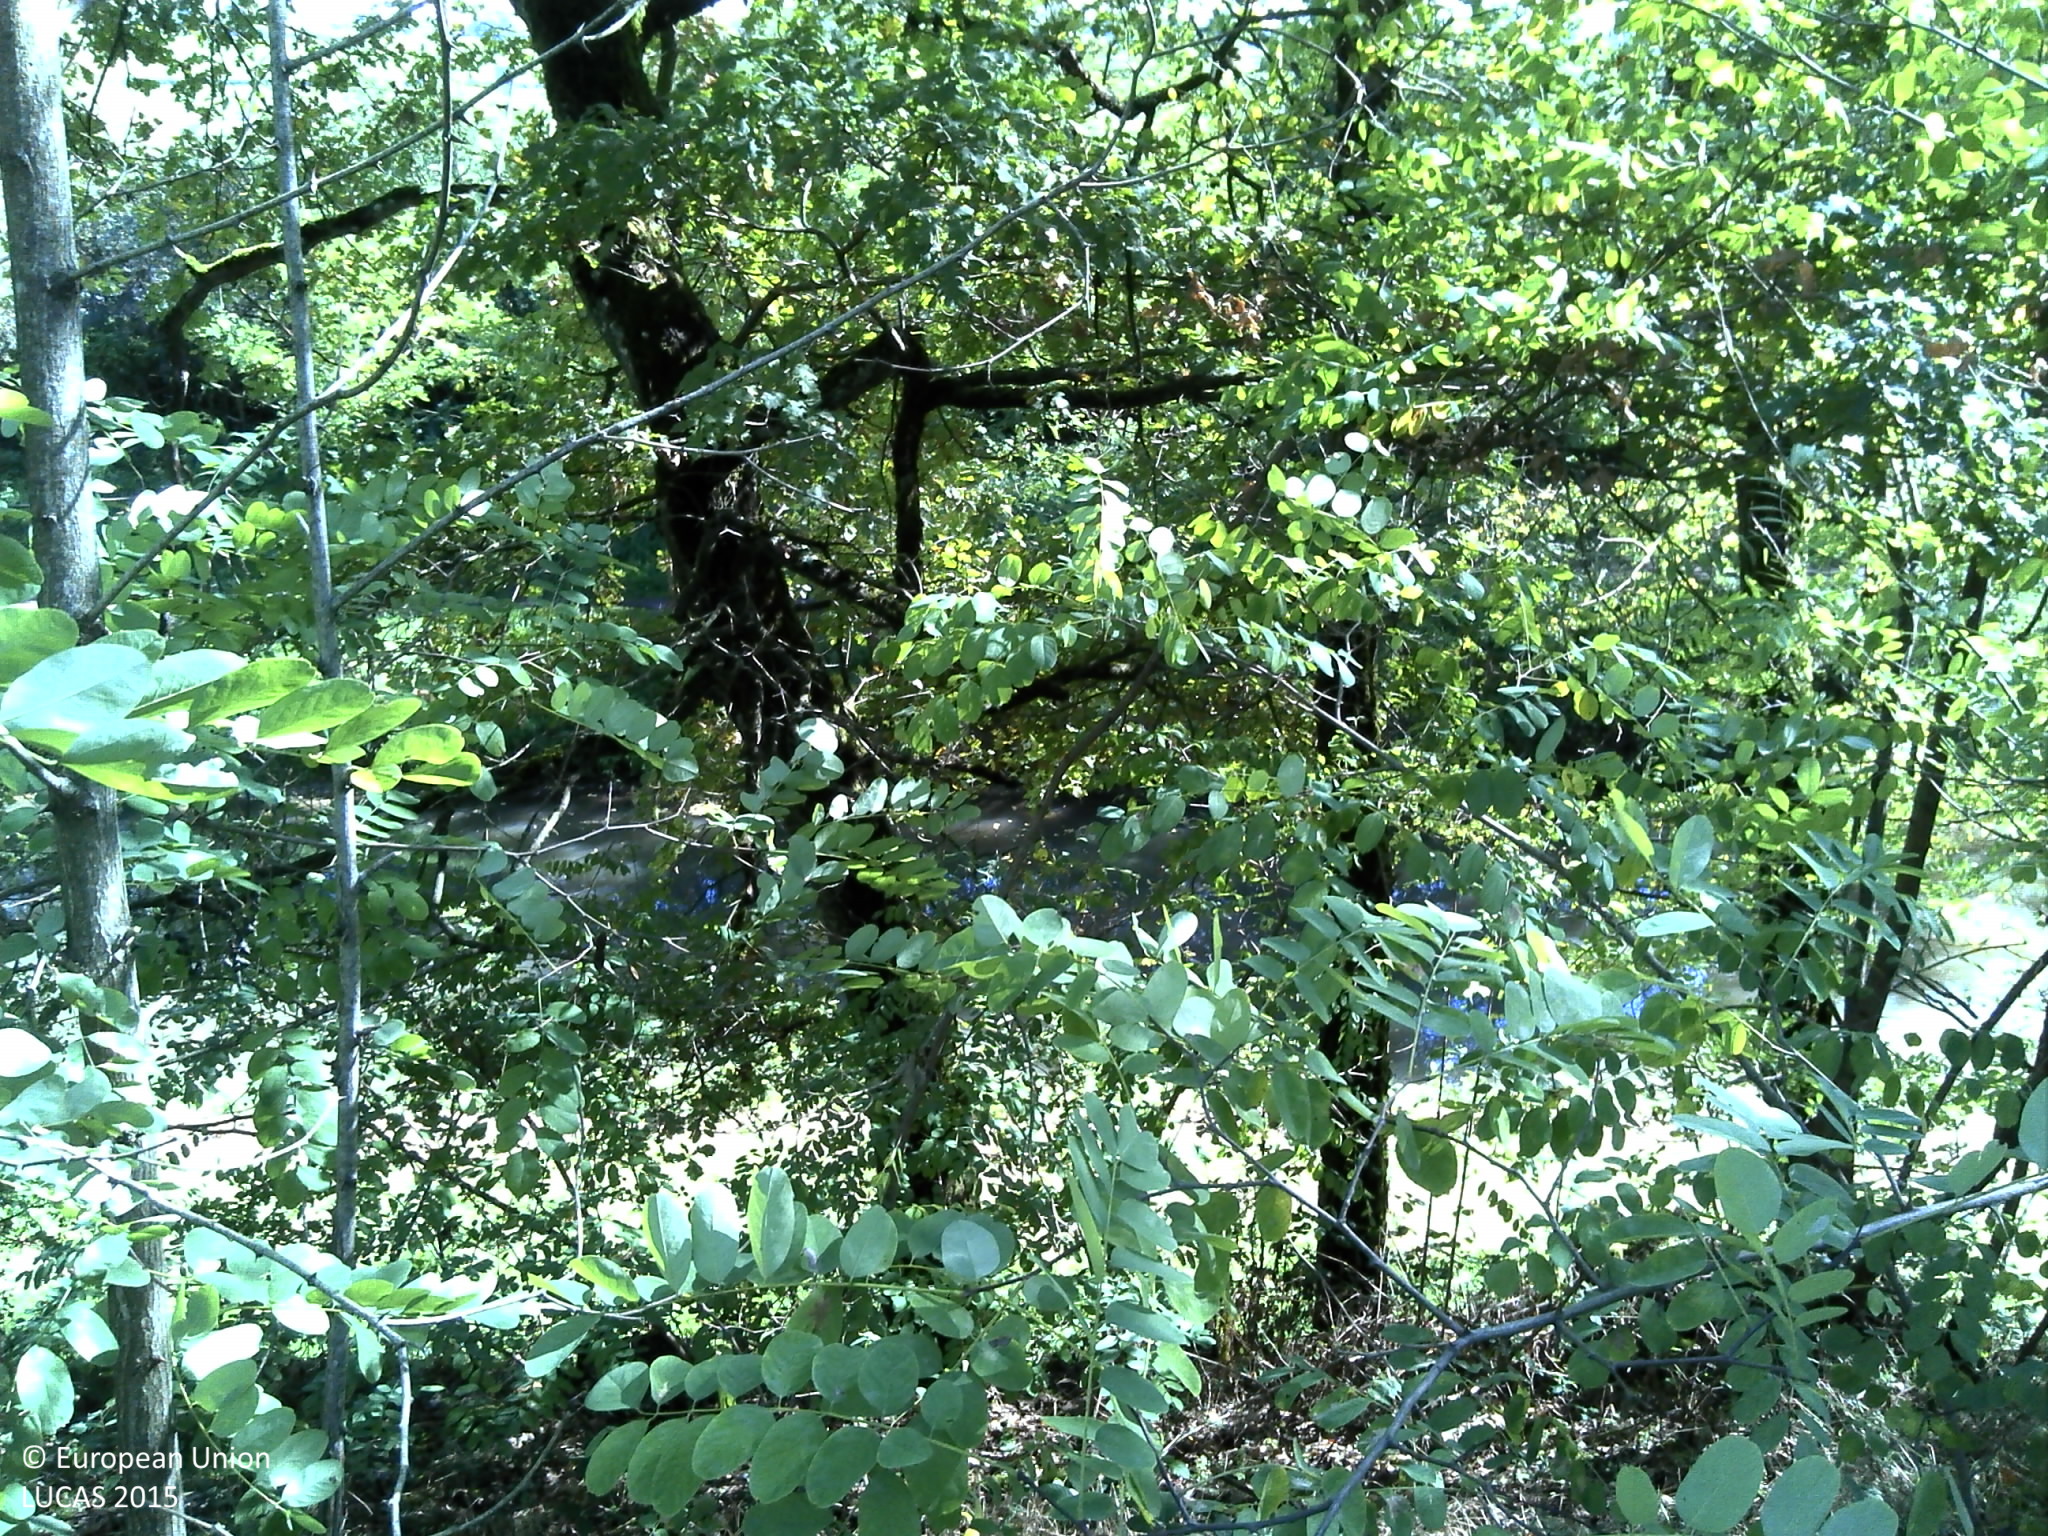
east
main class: Woodland
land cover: Broadleaved woodland
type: mesophytic deciduous forest
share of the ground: > 75 %
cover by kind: broadleaved forest trees 80 %, herbaceous plants 20 %
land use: Semi-natural and natural areas not in use
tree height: > 5 m
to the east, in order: Broadleaved woodland; Grassland without tree/shrub cover; Inland fresh running water; Lines of trees; Tracks; Lines of trees; Paved roads, cycling and walking lanes; Shrubland without tree cover; Electric lines; Ditches and canals; Paved roads, cycling and walking lanes; Grass margins; Ditches and canals; Fences; Grassland without tree/shrub cover; Fences; Ditches and canals; Grass margins; Paved roads, cycling and walking lanes; Grass margins; Ditches and canals; Fences; Other bare soil; Fences; Grassland without tree/shrub cover
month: October
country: FR
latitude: 46.5835
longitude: 4.0623
